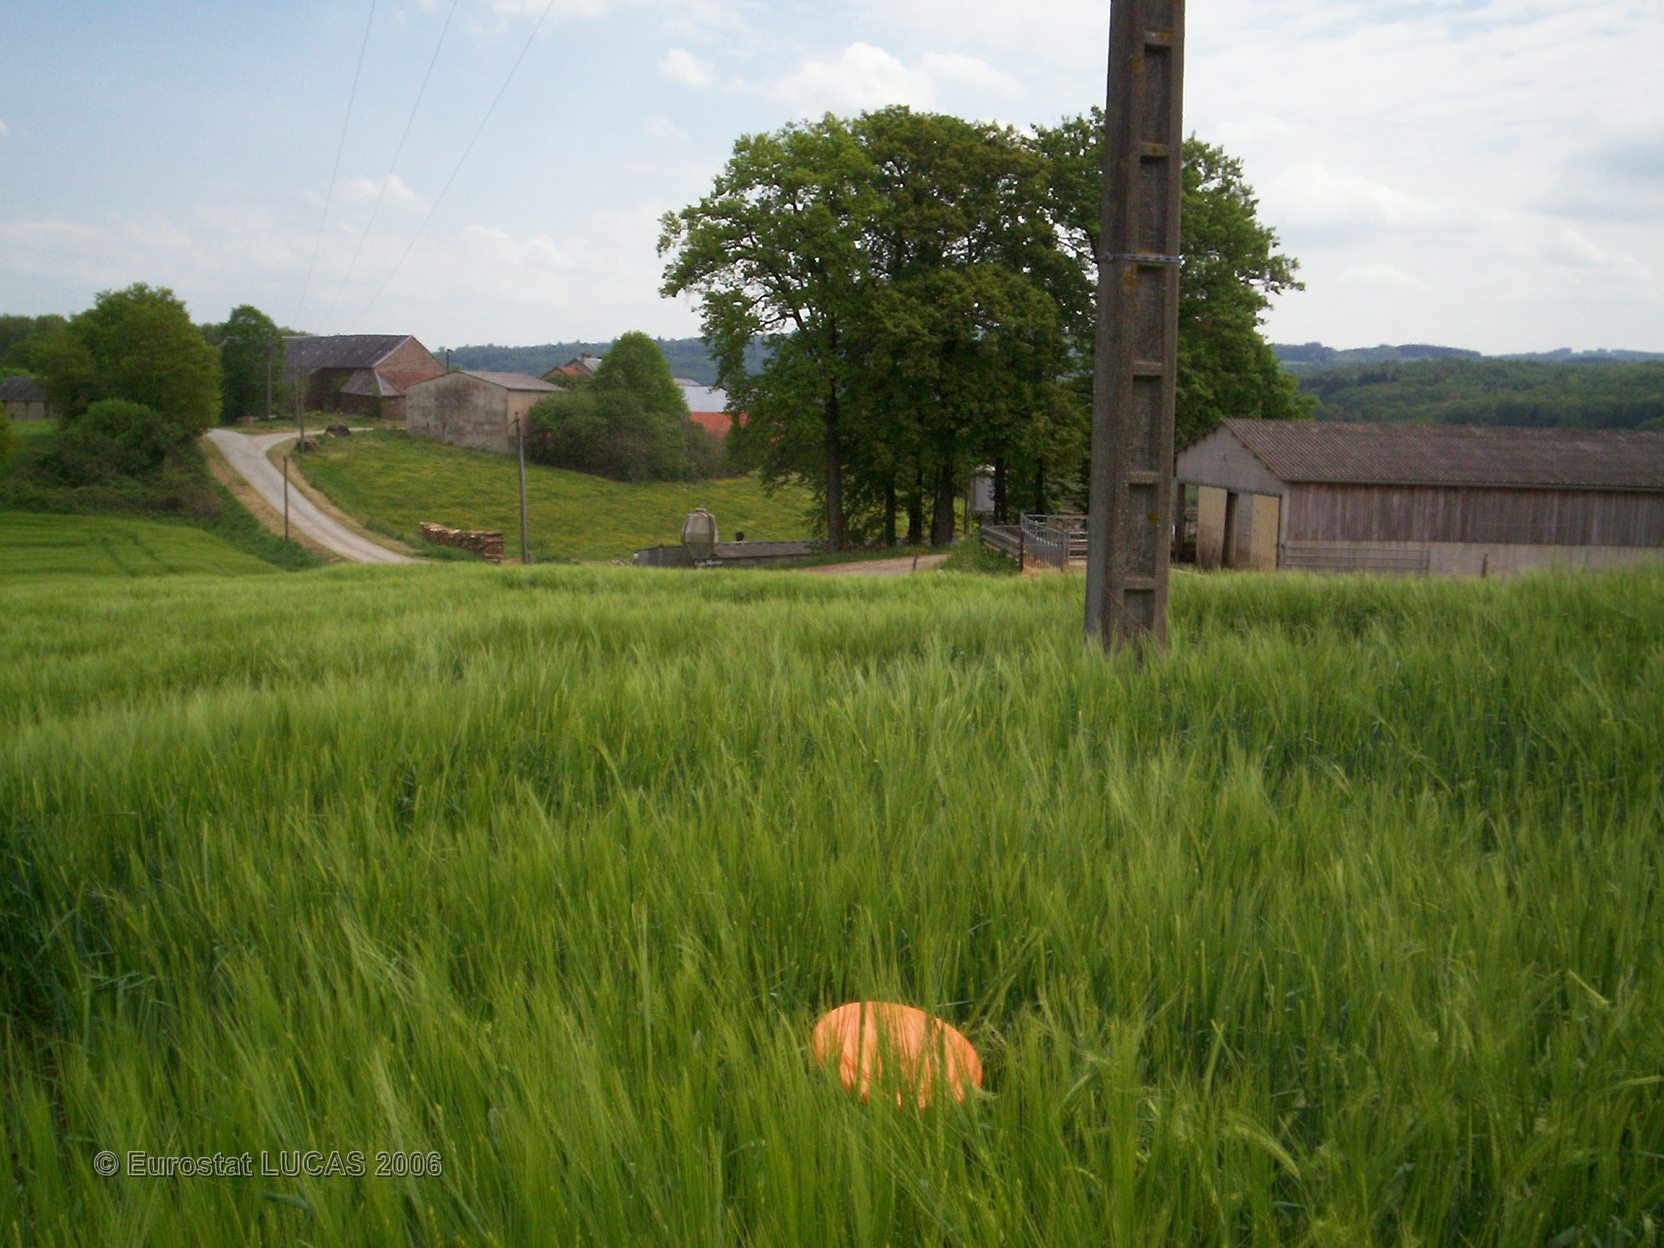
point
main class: Cropland
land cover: Barley
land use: Agriculture (excluding fallow land and kitchen gardens)
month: May
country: FR
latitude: 46.1023
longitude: 1.4920
